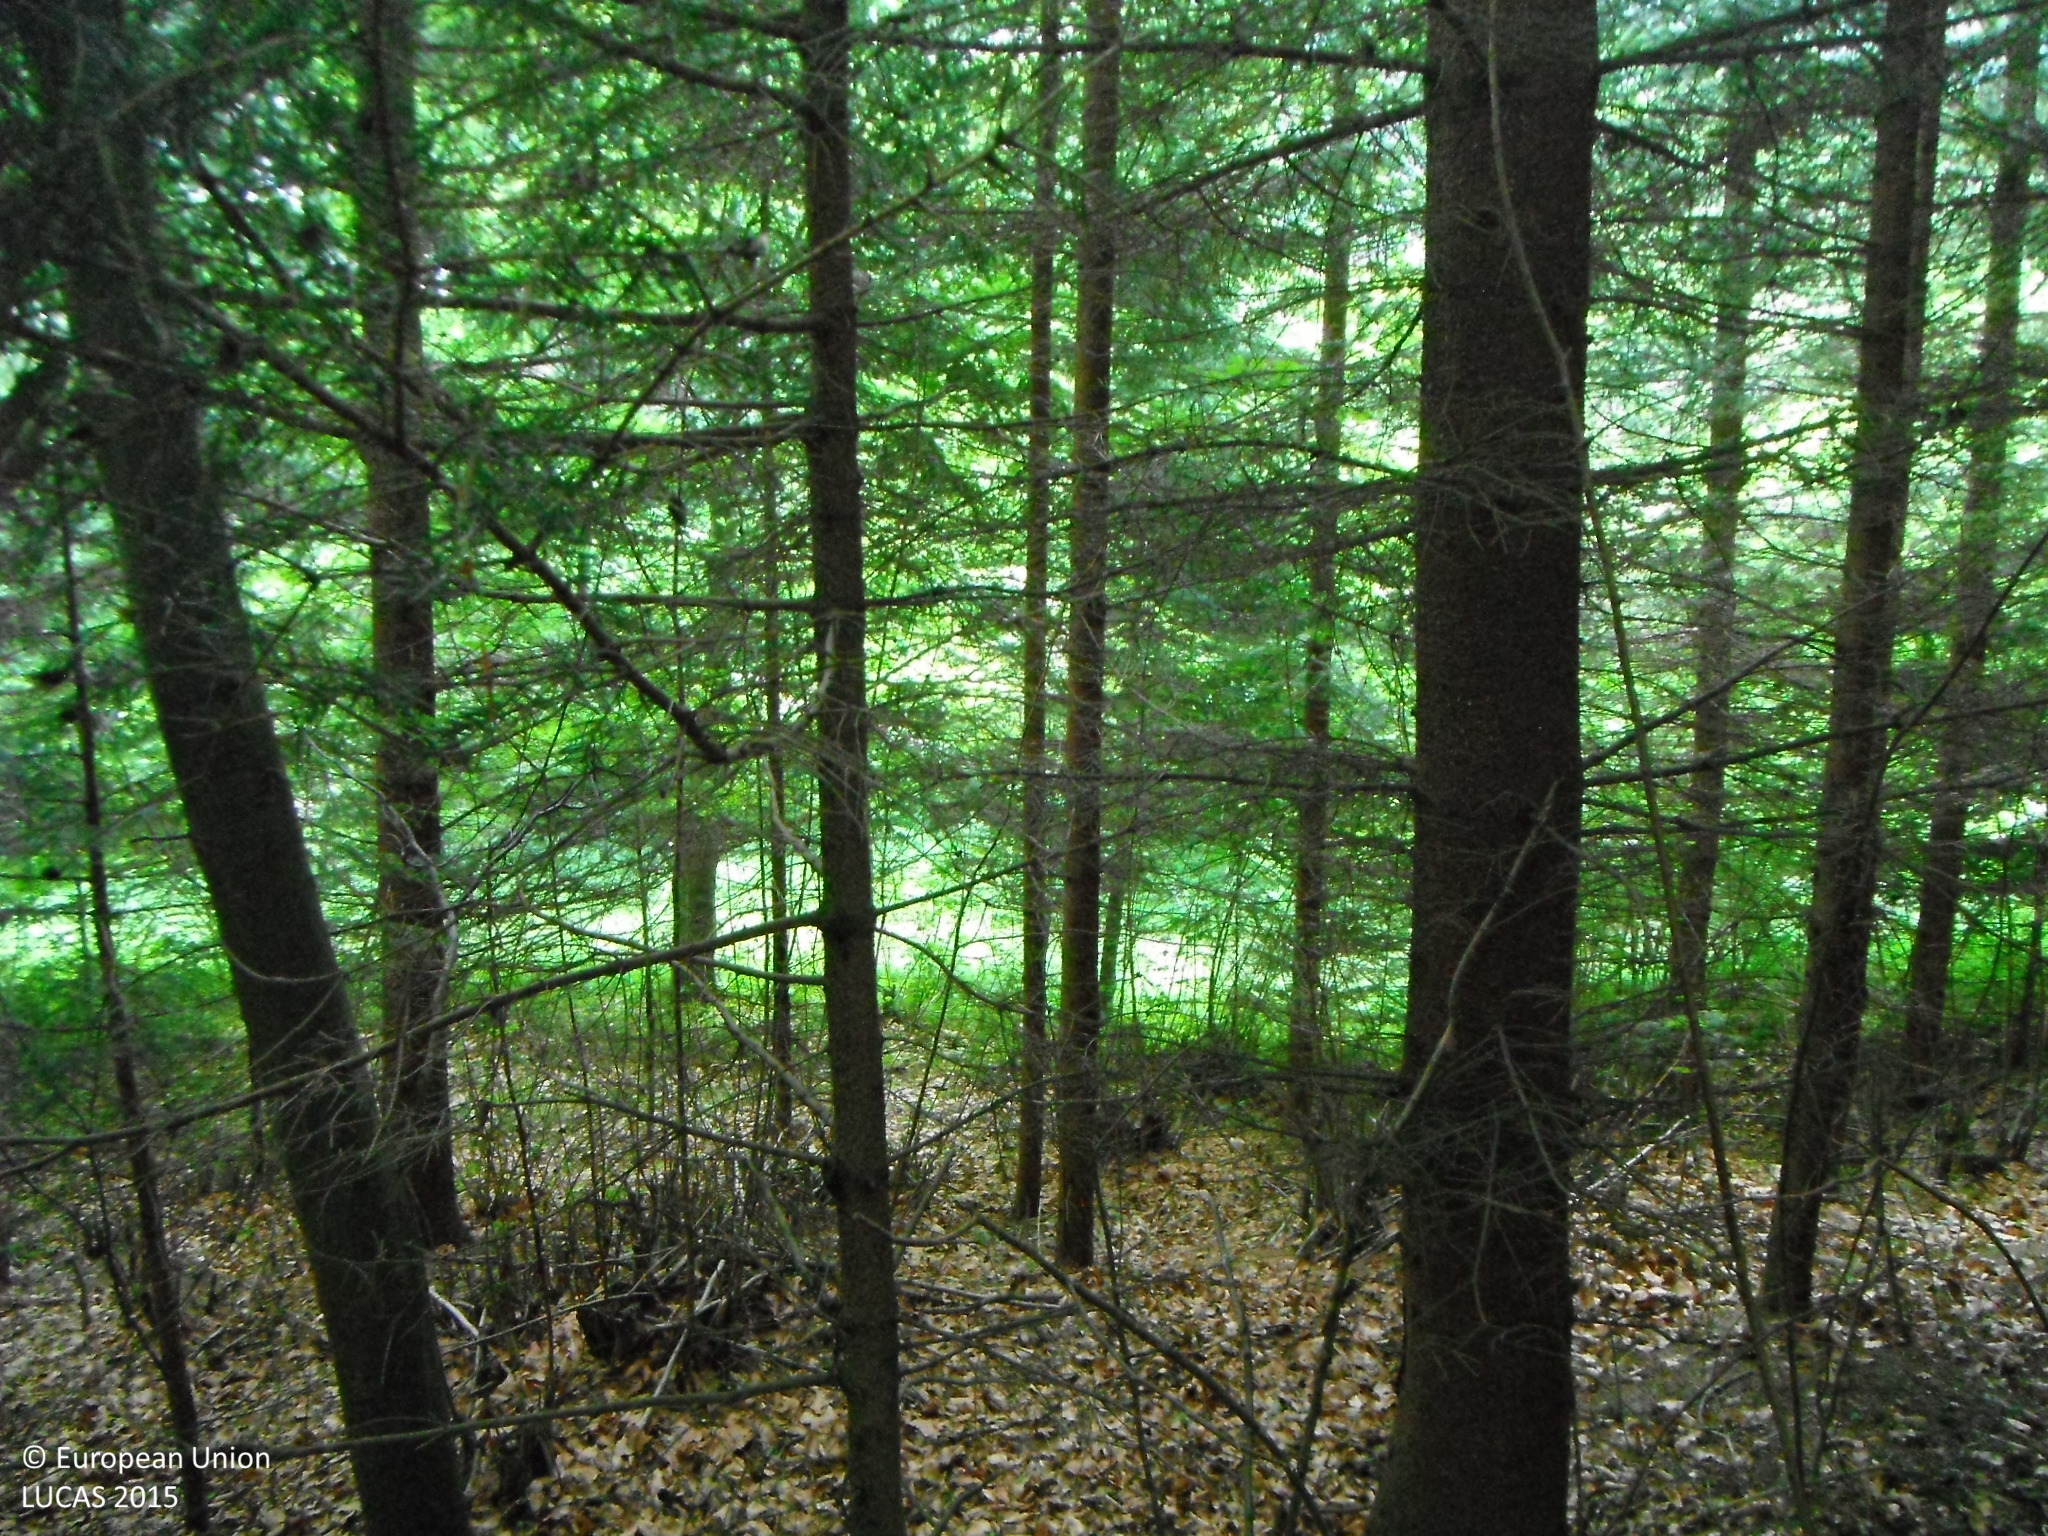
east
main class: Woodland
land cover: Spruce dominated mixed woodland
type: alpine coniferous forest
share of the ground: > 75 %
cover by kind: coniferous forest trees 70 %, broadleaved forest trees 30 %
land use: Forestry
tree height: > 5 m
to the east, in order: Spruce dominated mixed woodland; Tracks; Spruce dominated coniferous woodland; Rivers and streams; Spruce dominated coniferous woodland; Grassland without tree/shrub cover; Shrubland without tree cover; Grassland without tree/shrub cover; Tracks; Grassland with sparse tree/shrub cover; Spruce dominated coniferous woodland; Grassland without tree/shrub cover
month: June
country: SK
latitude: 49.1534
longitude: 19.2792
